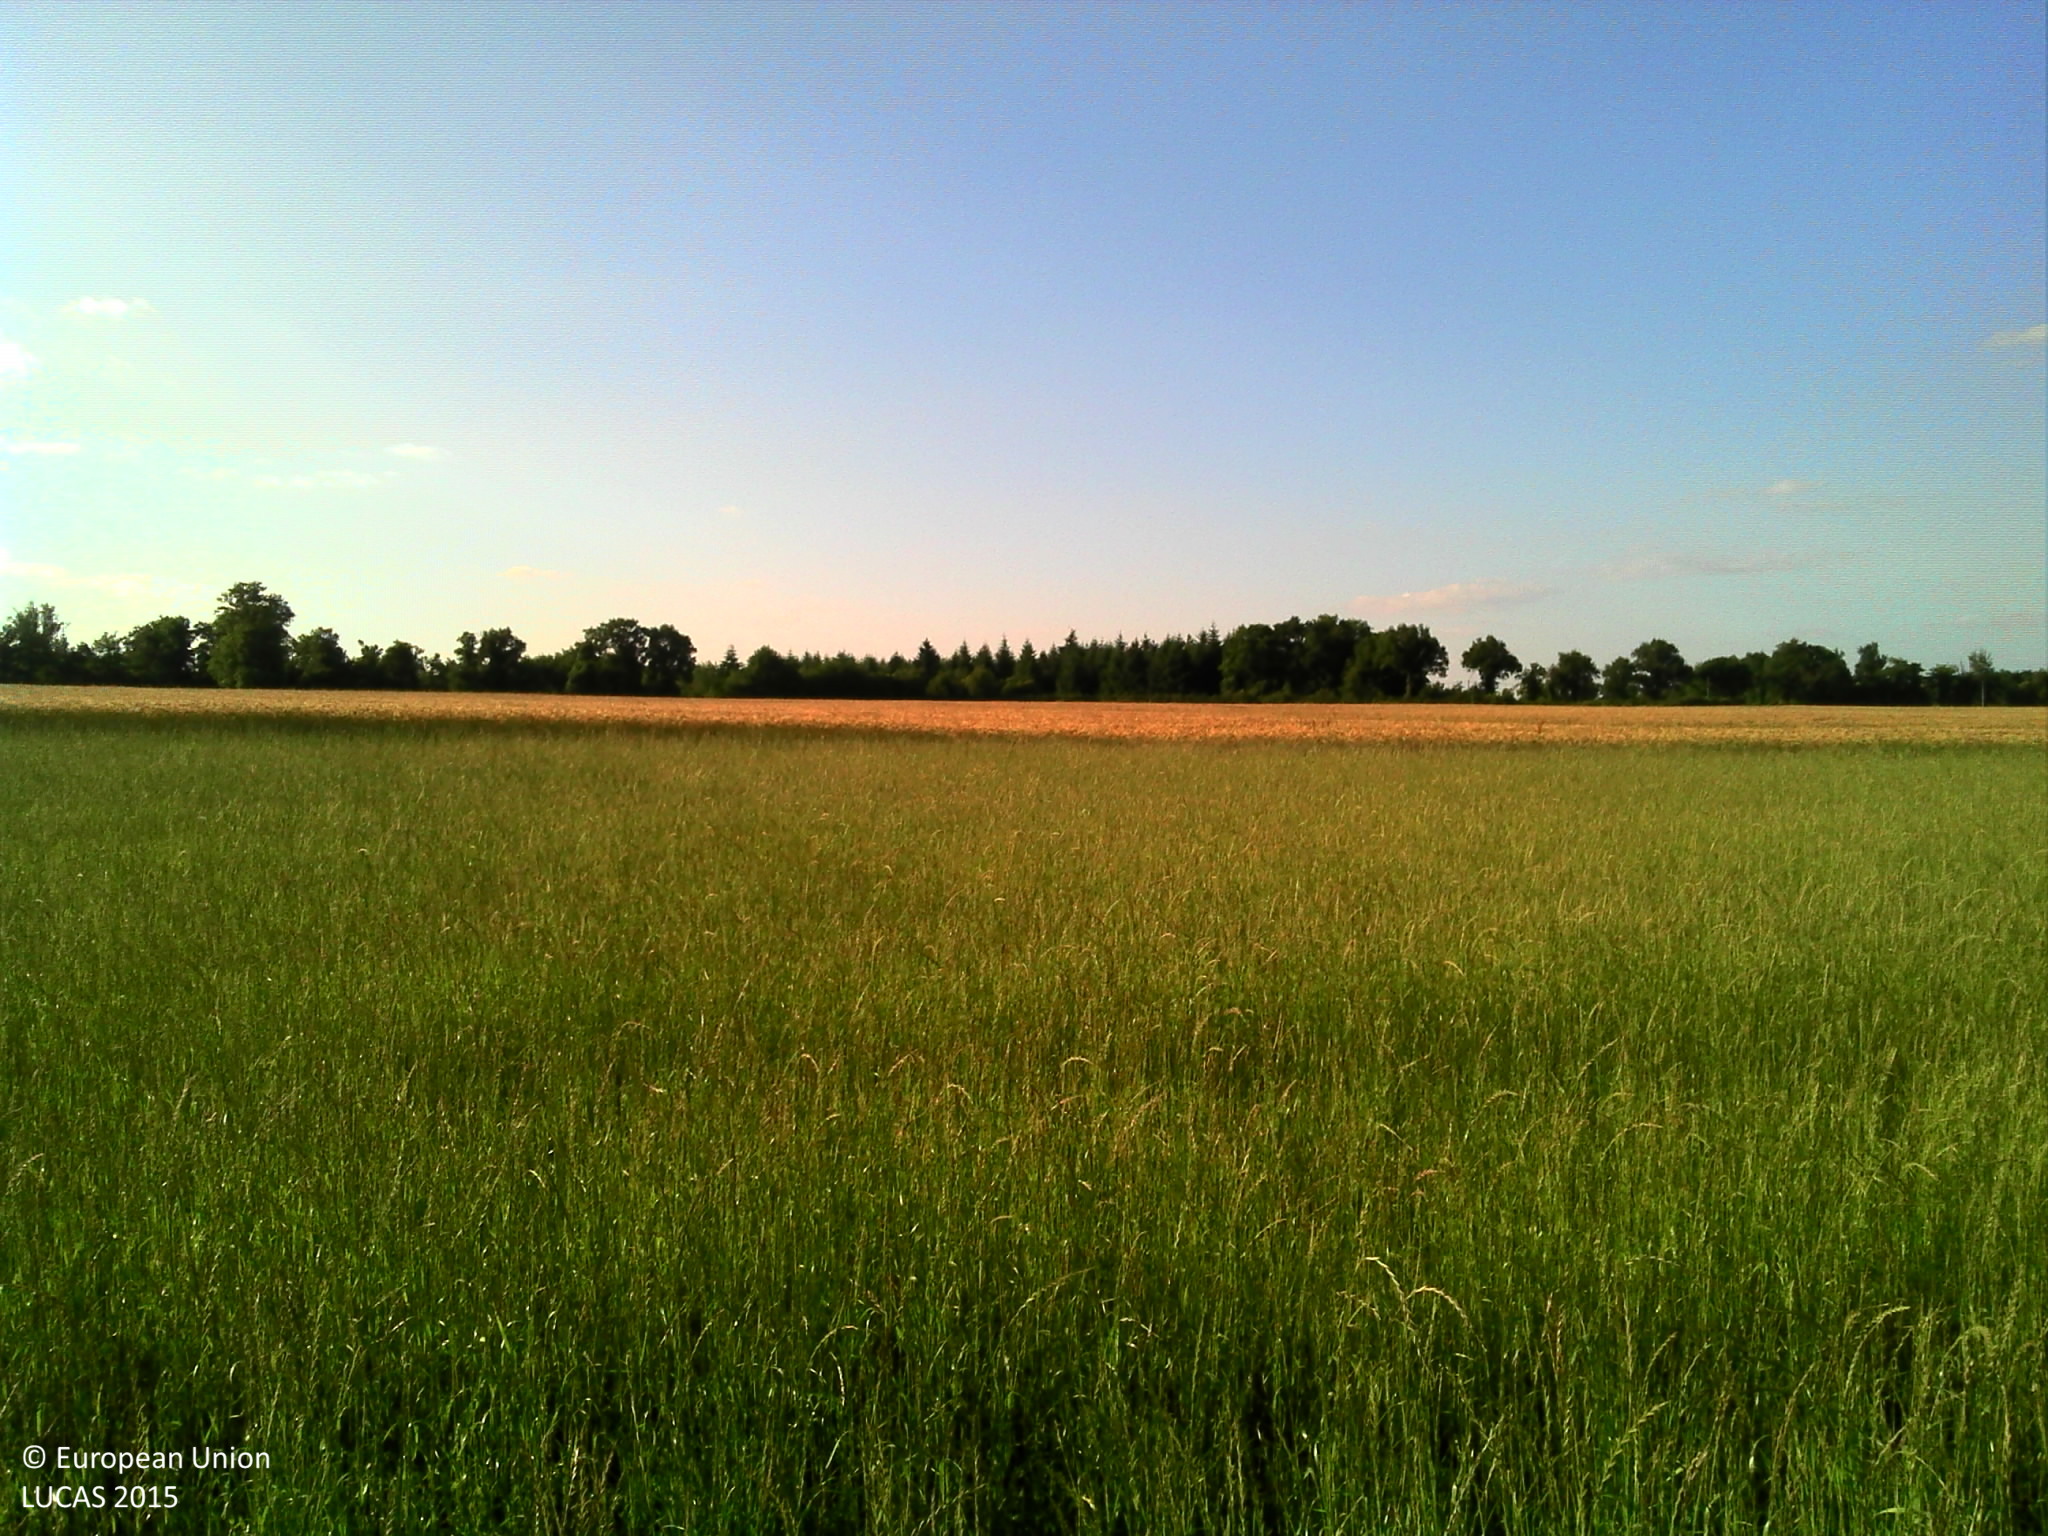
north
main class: Cropland
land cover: Temporary grasslands
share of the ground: > 75 %
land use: Agriculture (excluding fallow land and kitchen gardens)
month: June
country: FR
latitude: 45.9551
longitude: 0.6060
